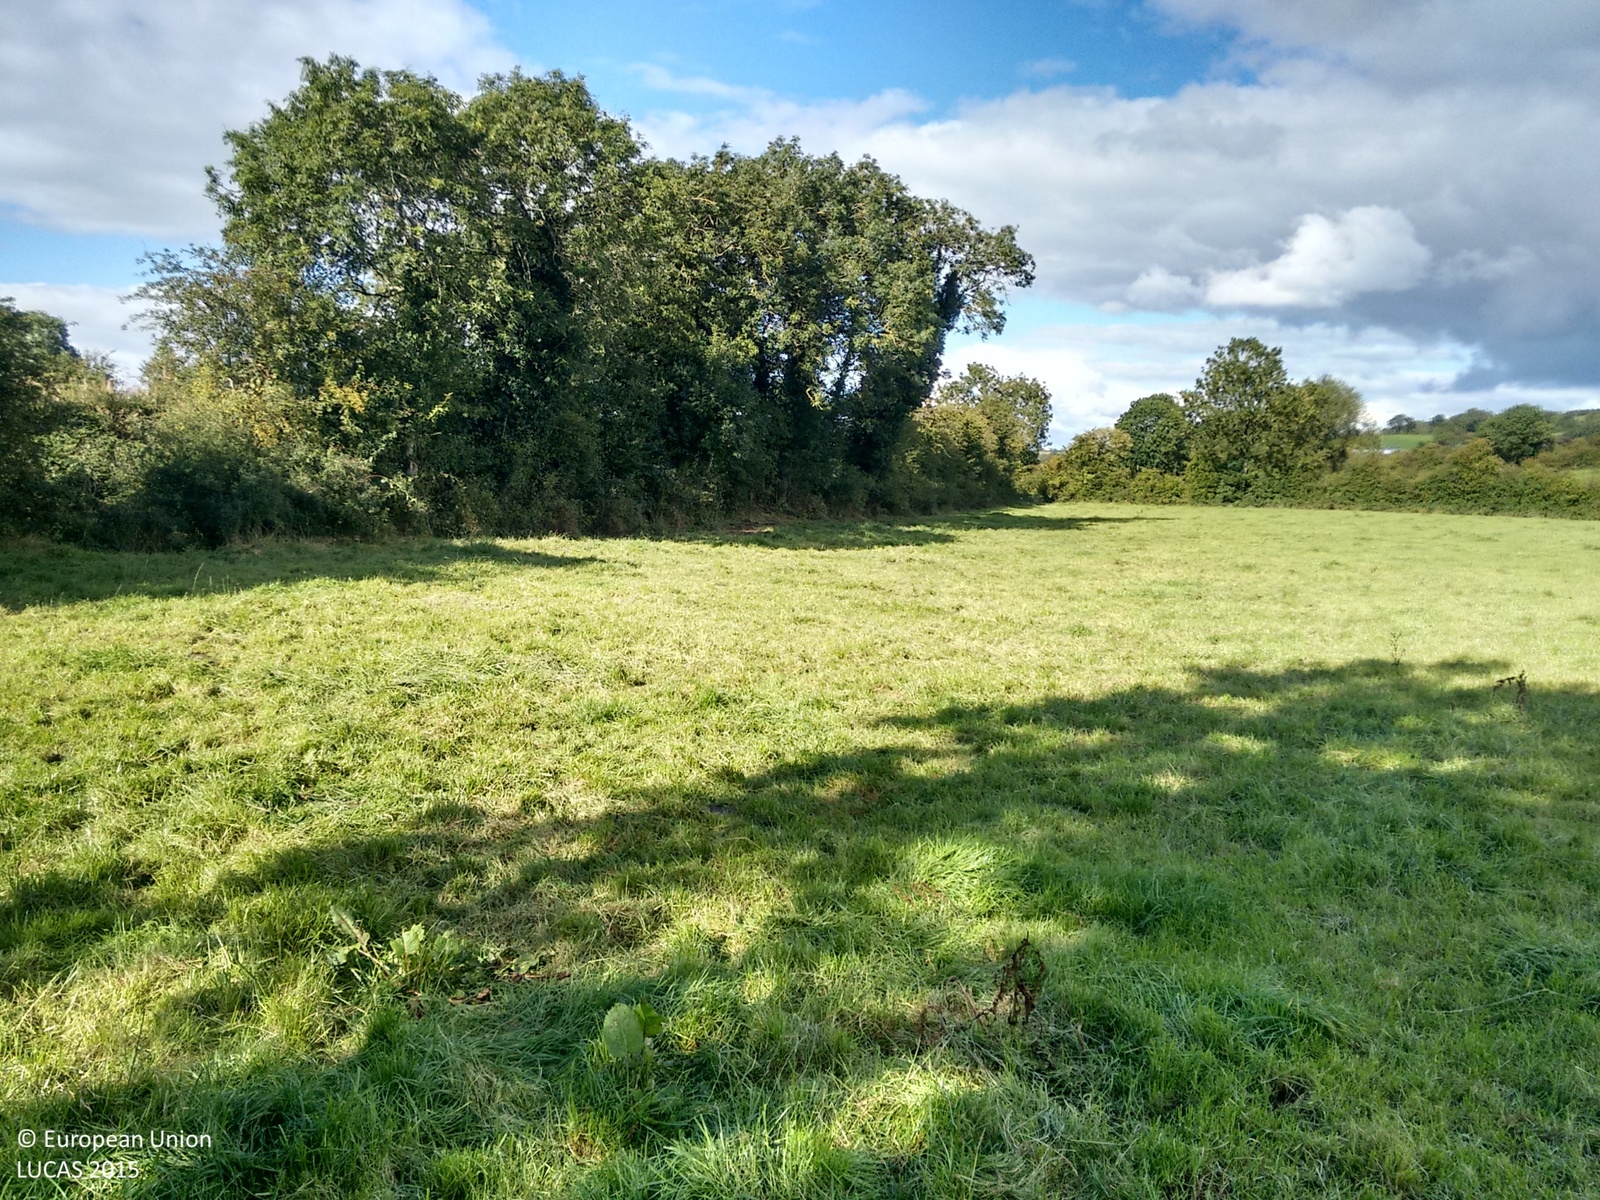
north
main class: Grassland
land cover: Grassland without tree/shrub cover
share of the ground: > 75 %
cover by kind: herbaceous plants 95 %, shrubs 5 %
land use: Agriculture (excluding fallow land and kitchen gardens)
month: September
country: IE
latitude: 54.2335
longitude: -6.8425
